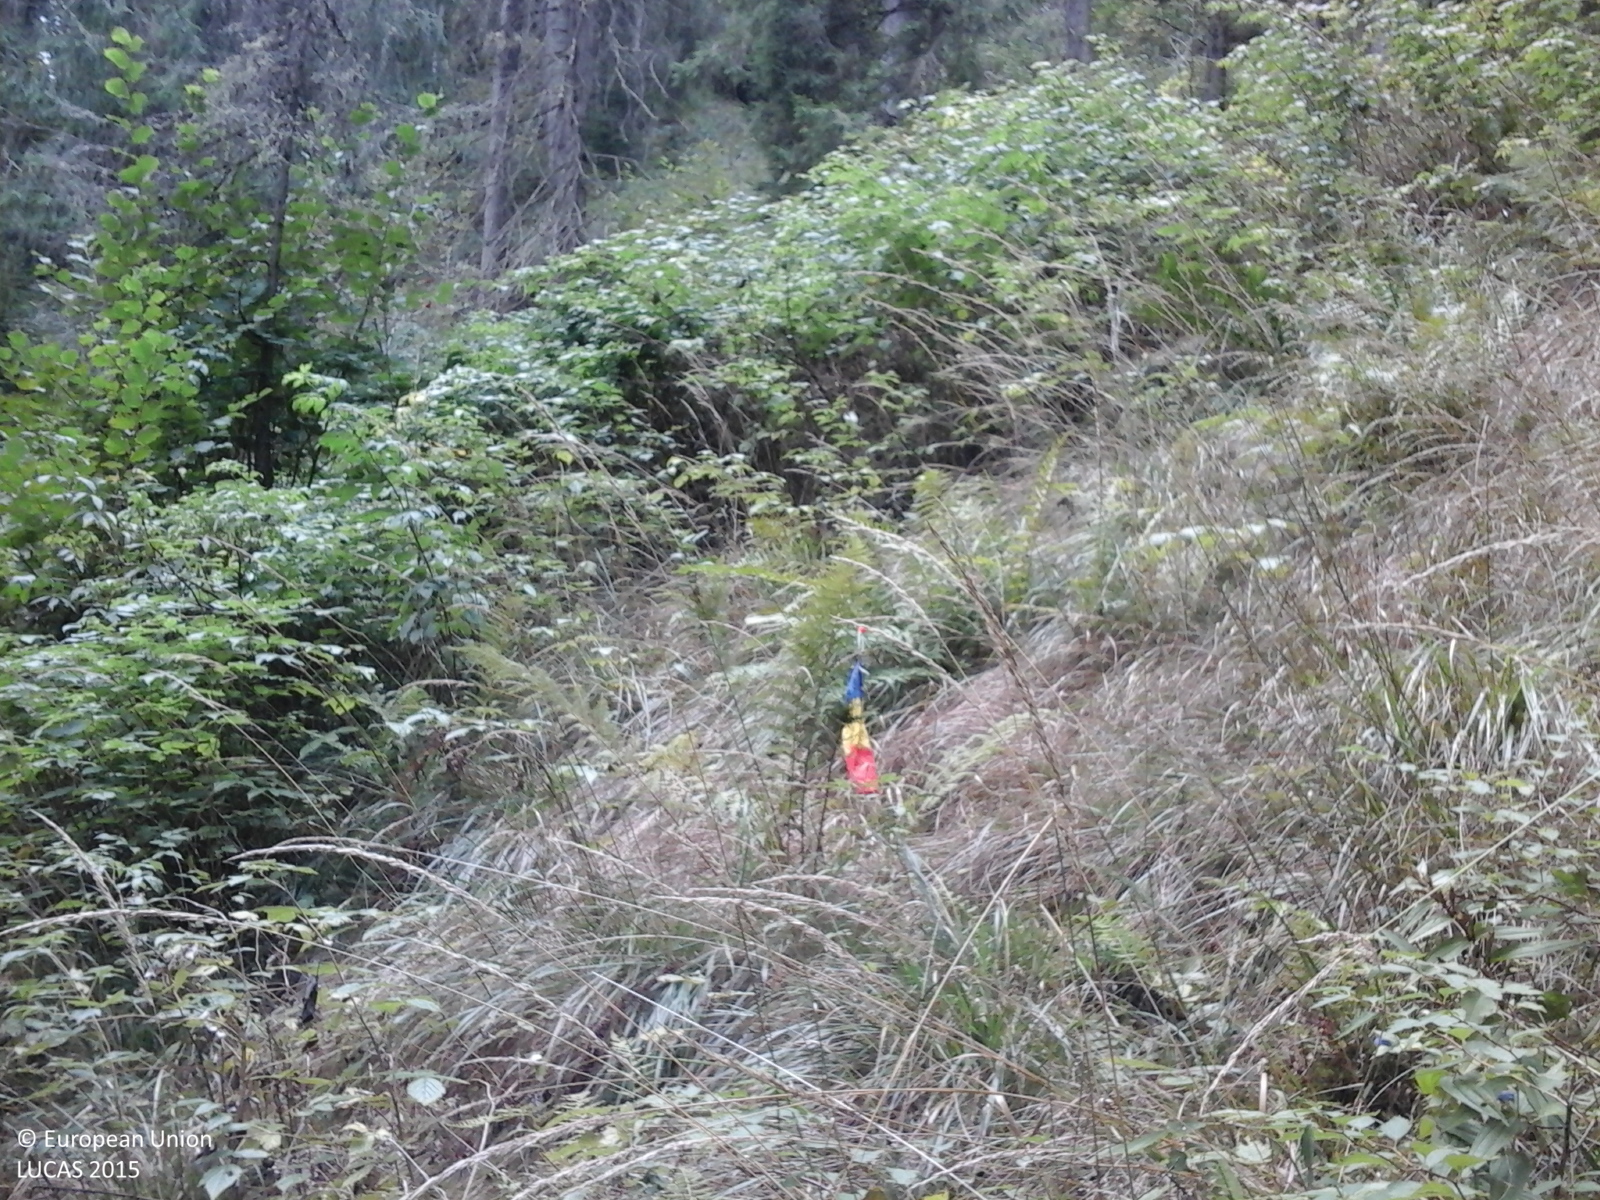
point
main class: Woodland
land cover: Spruce dominated coniferous woodland
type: alpine coniferous forest
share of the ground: > 75 %
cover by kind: coniferous forest trees 75 %, shrubs 10 %, herbaceous plants 10 %, broadleaved forest trees 5 %
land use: Forestry
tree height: > 5 m
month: September
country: RO
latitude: 46.6677
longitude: 22.9867
